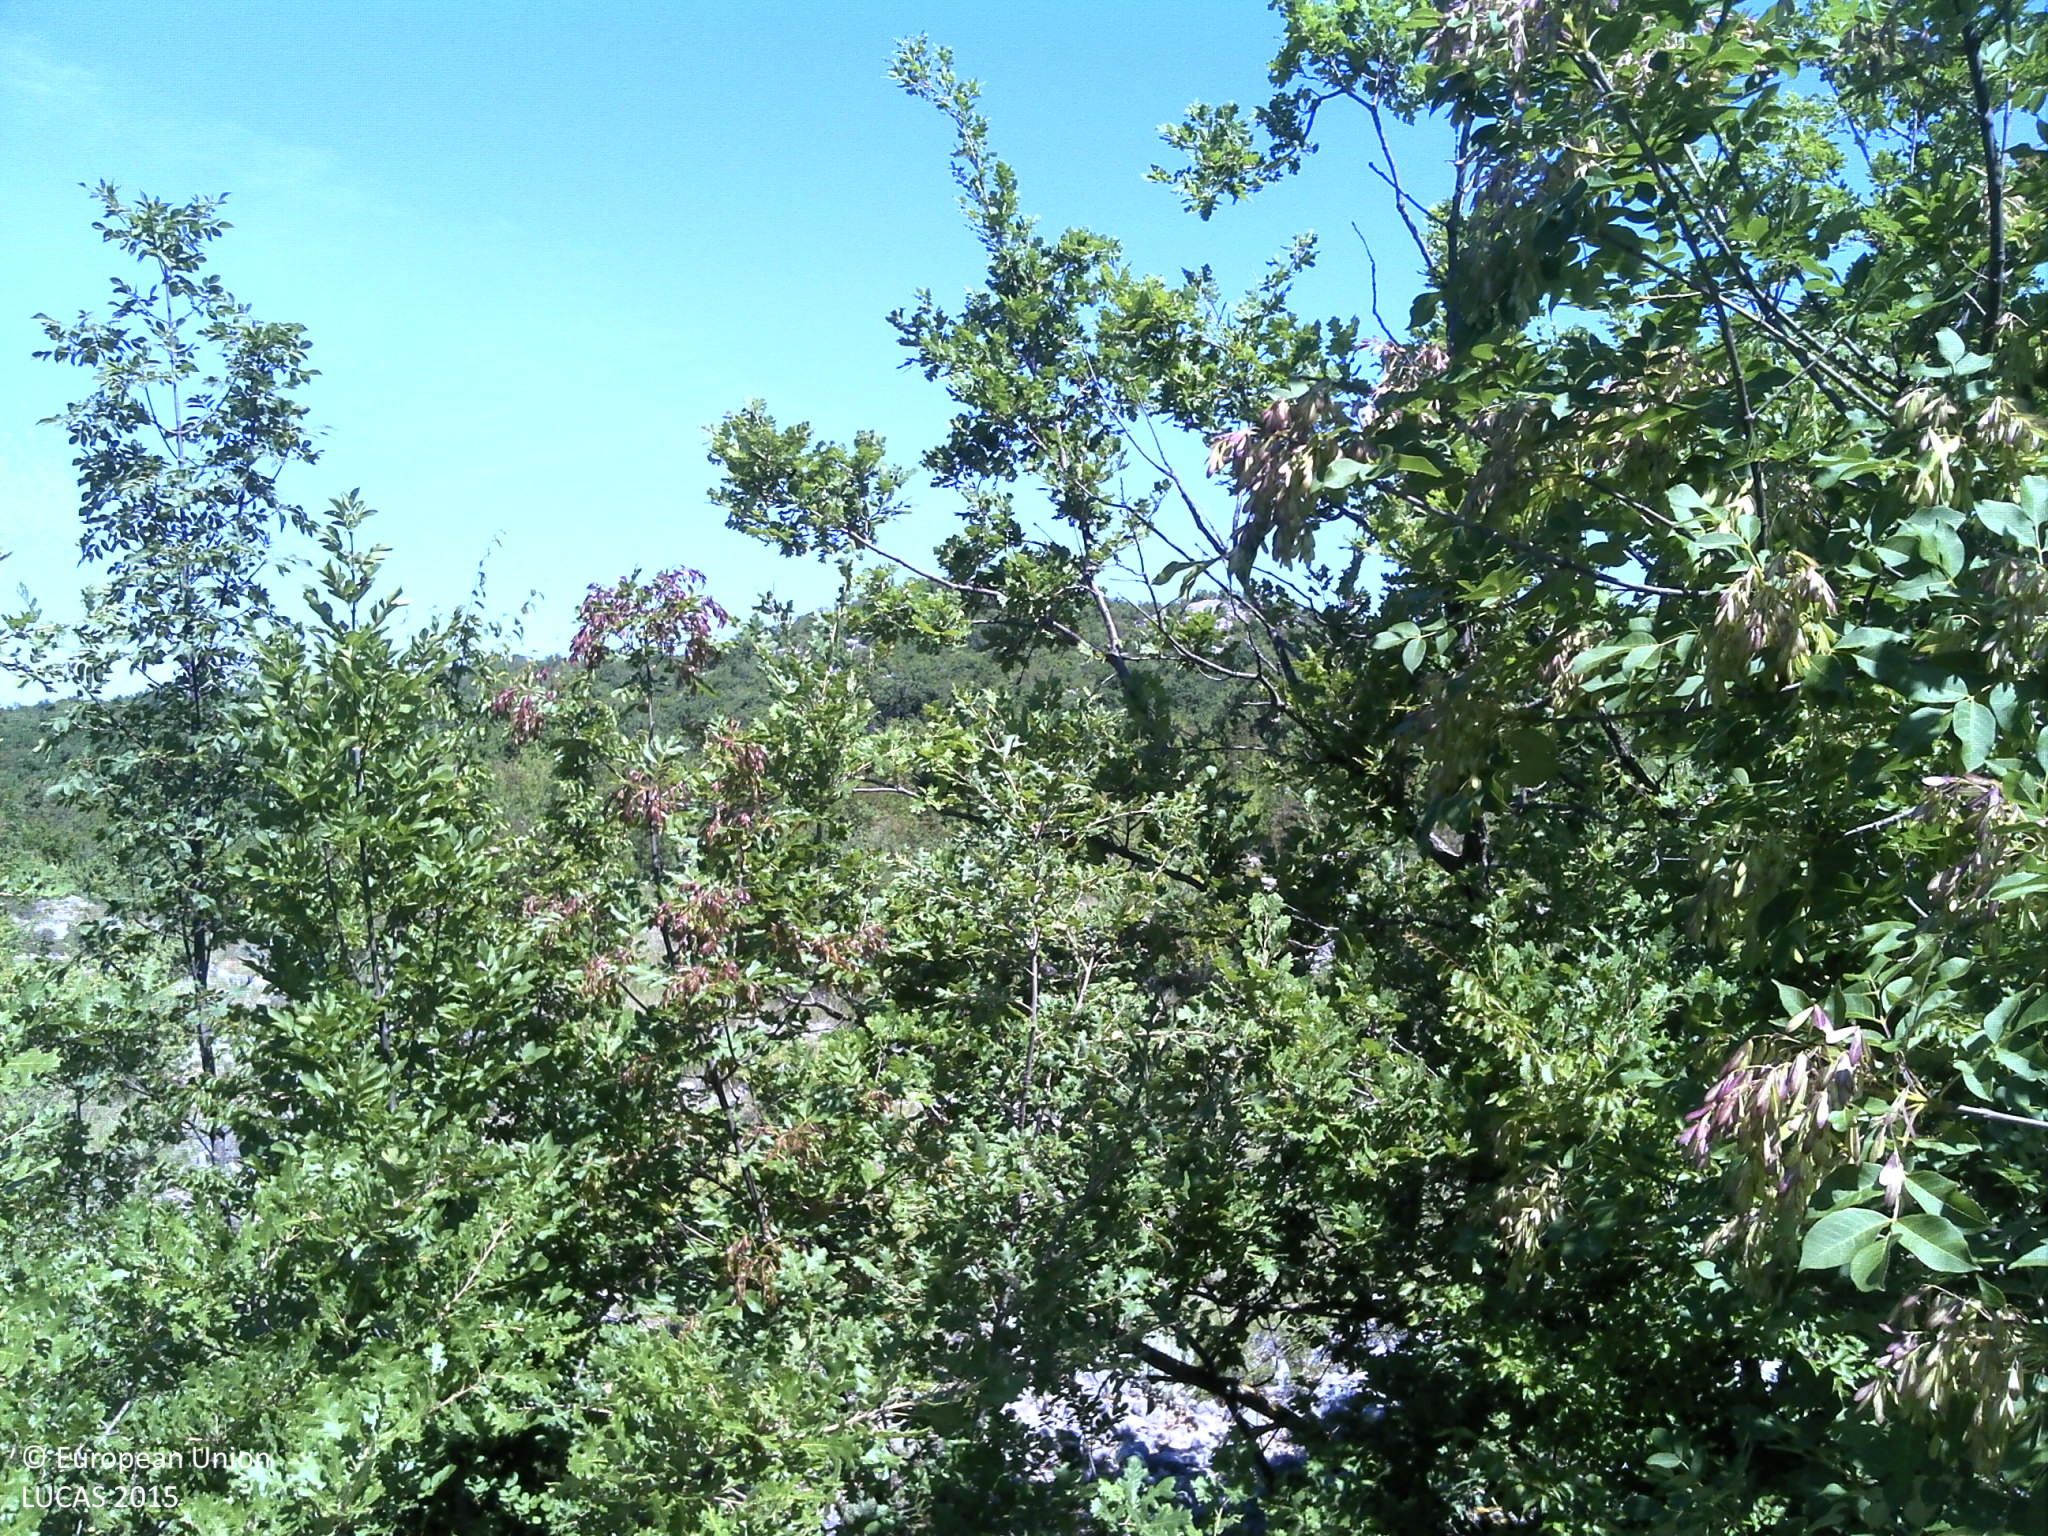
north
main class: Woodland
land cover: Broadleaved woodland
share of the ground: 25 - 50 %
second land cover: Spontaneously vegetated surfaces
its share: 25 - 50 %
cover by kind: broadleaved forest trees 30 %, herbaceous plants 25 %, consolidated bare surface 20 %, unconsolidated bare surface 15 %, shrubs 10 %
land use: Forestry
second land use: Agriculture (excluding fallow land and kitchen gardens)
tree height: < 5 m
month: June
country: HR
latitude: 43.7663
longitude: 16.2150
